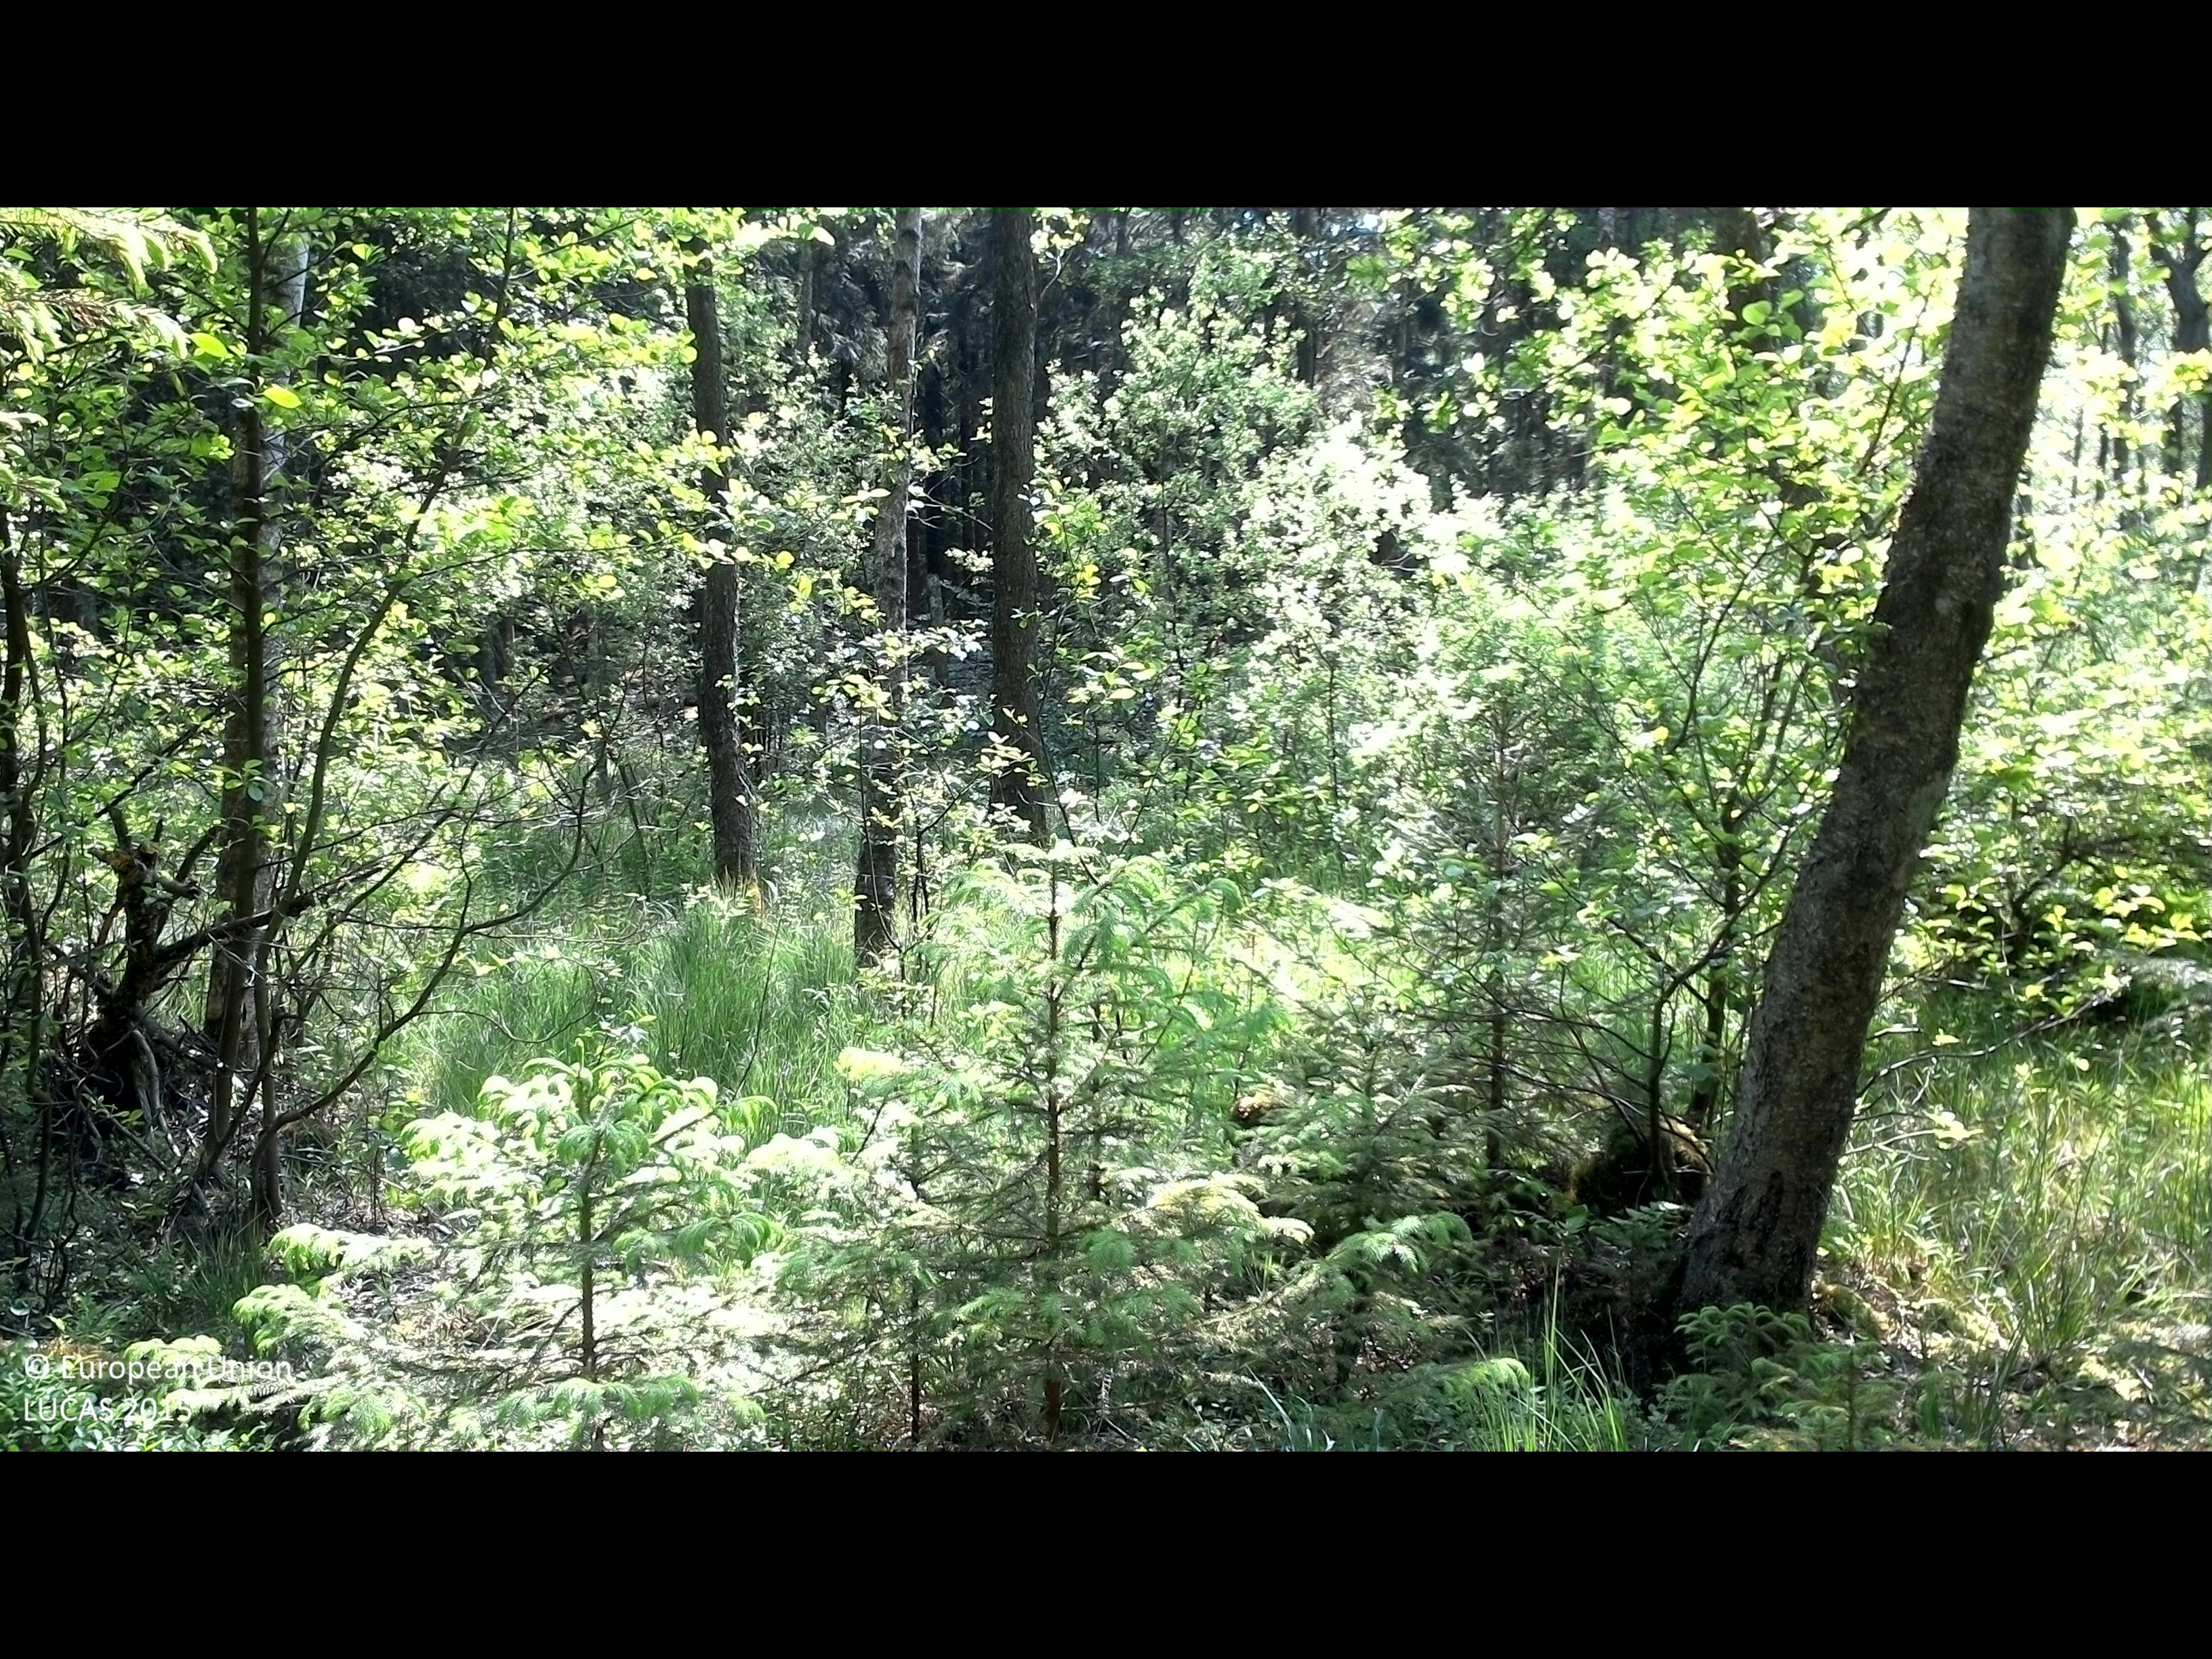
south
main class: Woodland
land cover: Spruce dominated mixed woodland
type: boreal forest
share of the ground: > 75 %
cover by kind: coniferous forest trees 45 %, broadleaved forest trees 35 %, shrubs 10 %, herbaceous plants 10 %
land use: Forestry
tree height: > 5 m
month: June
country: SE
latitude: 55.8014
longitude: 14.0023
